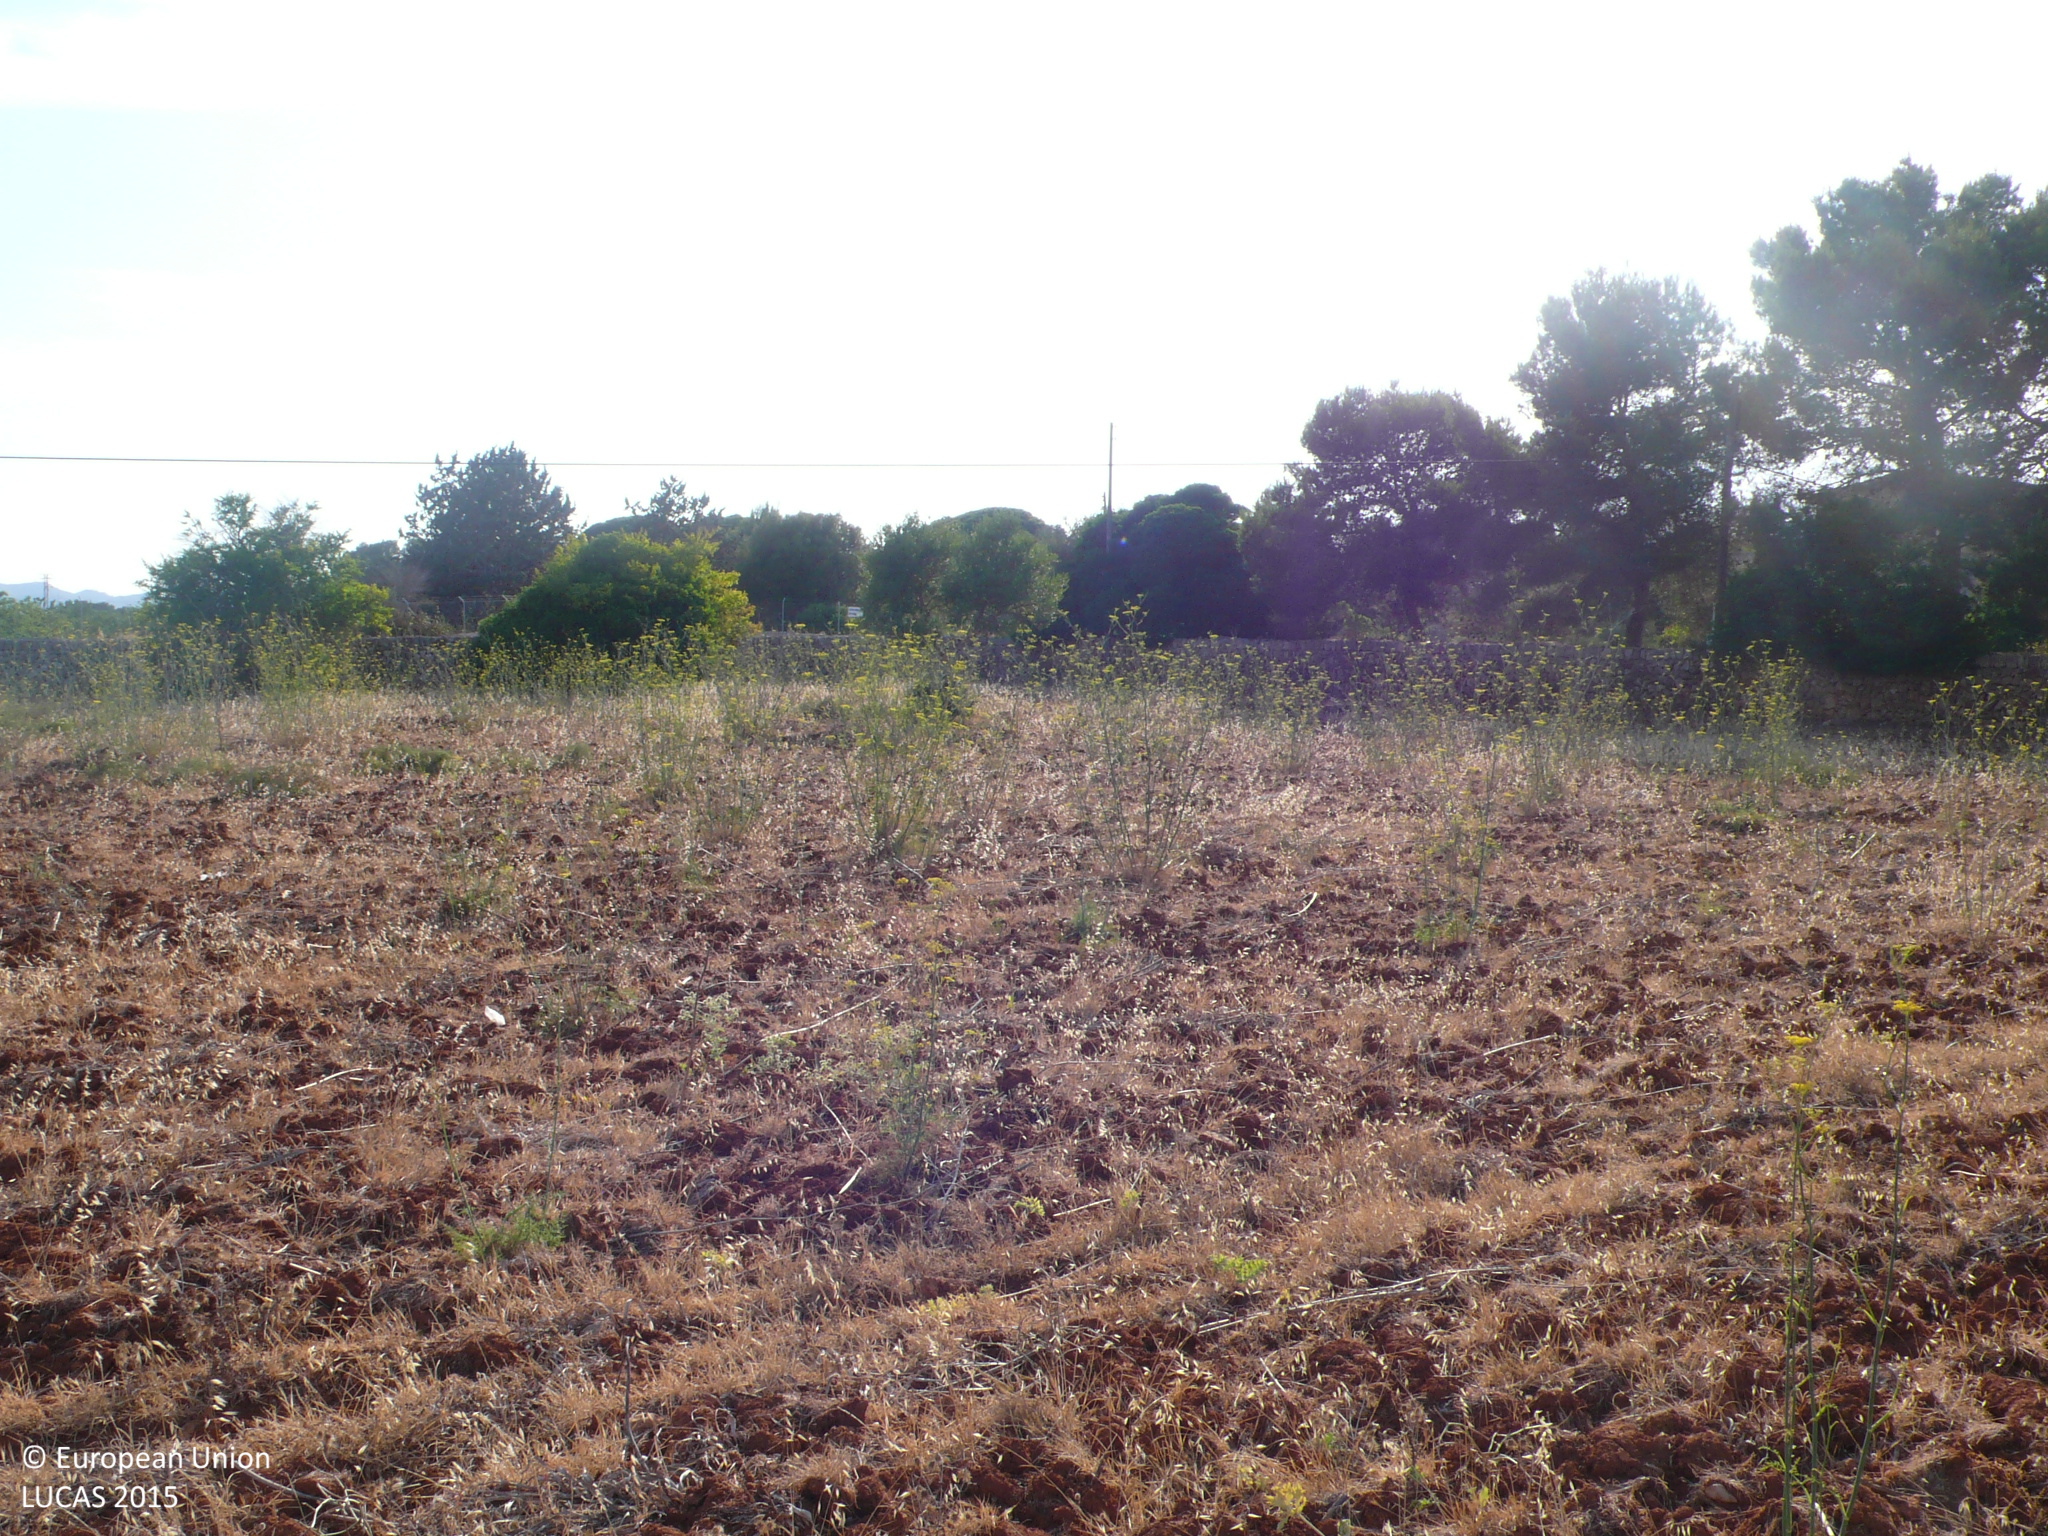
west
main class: Grassland
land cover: Spontaneously vegetated surfaces
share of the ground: 25 - 50 %
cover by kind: unconsolidated bare surface 65 %, herbaceous plants 35 %
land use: Fallow land
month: July
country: ES
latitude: 39.5504
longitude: 3.3384
